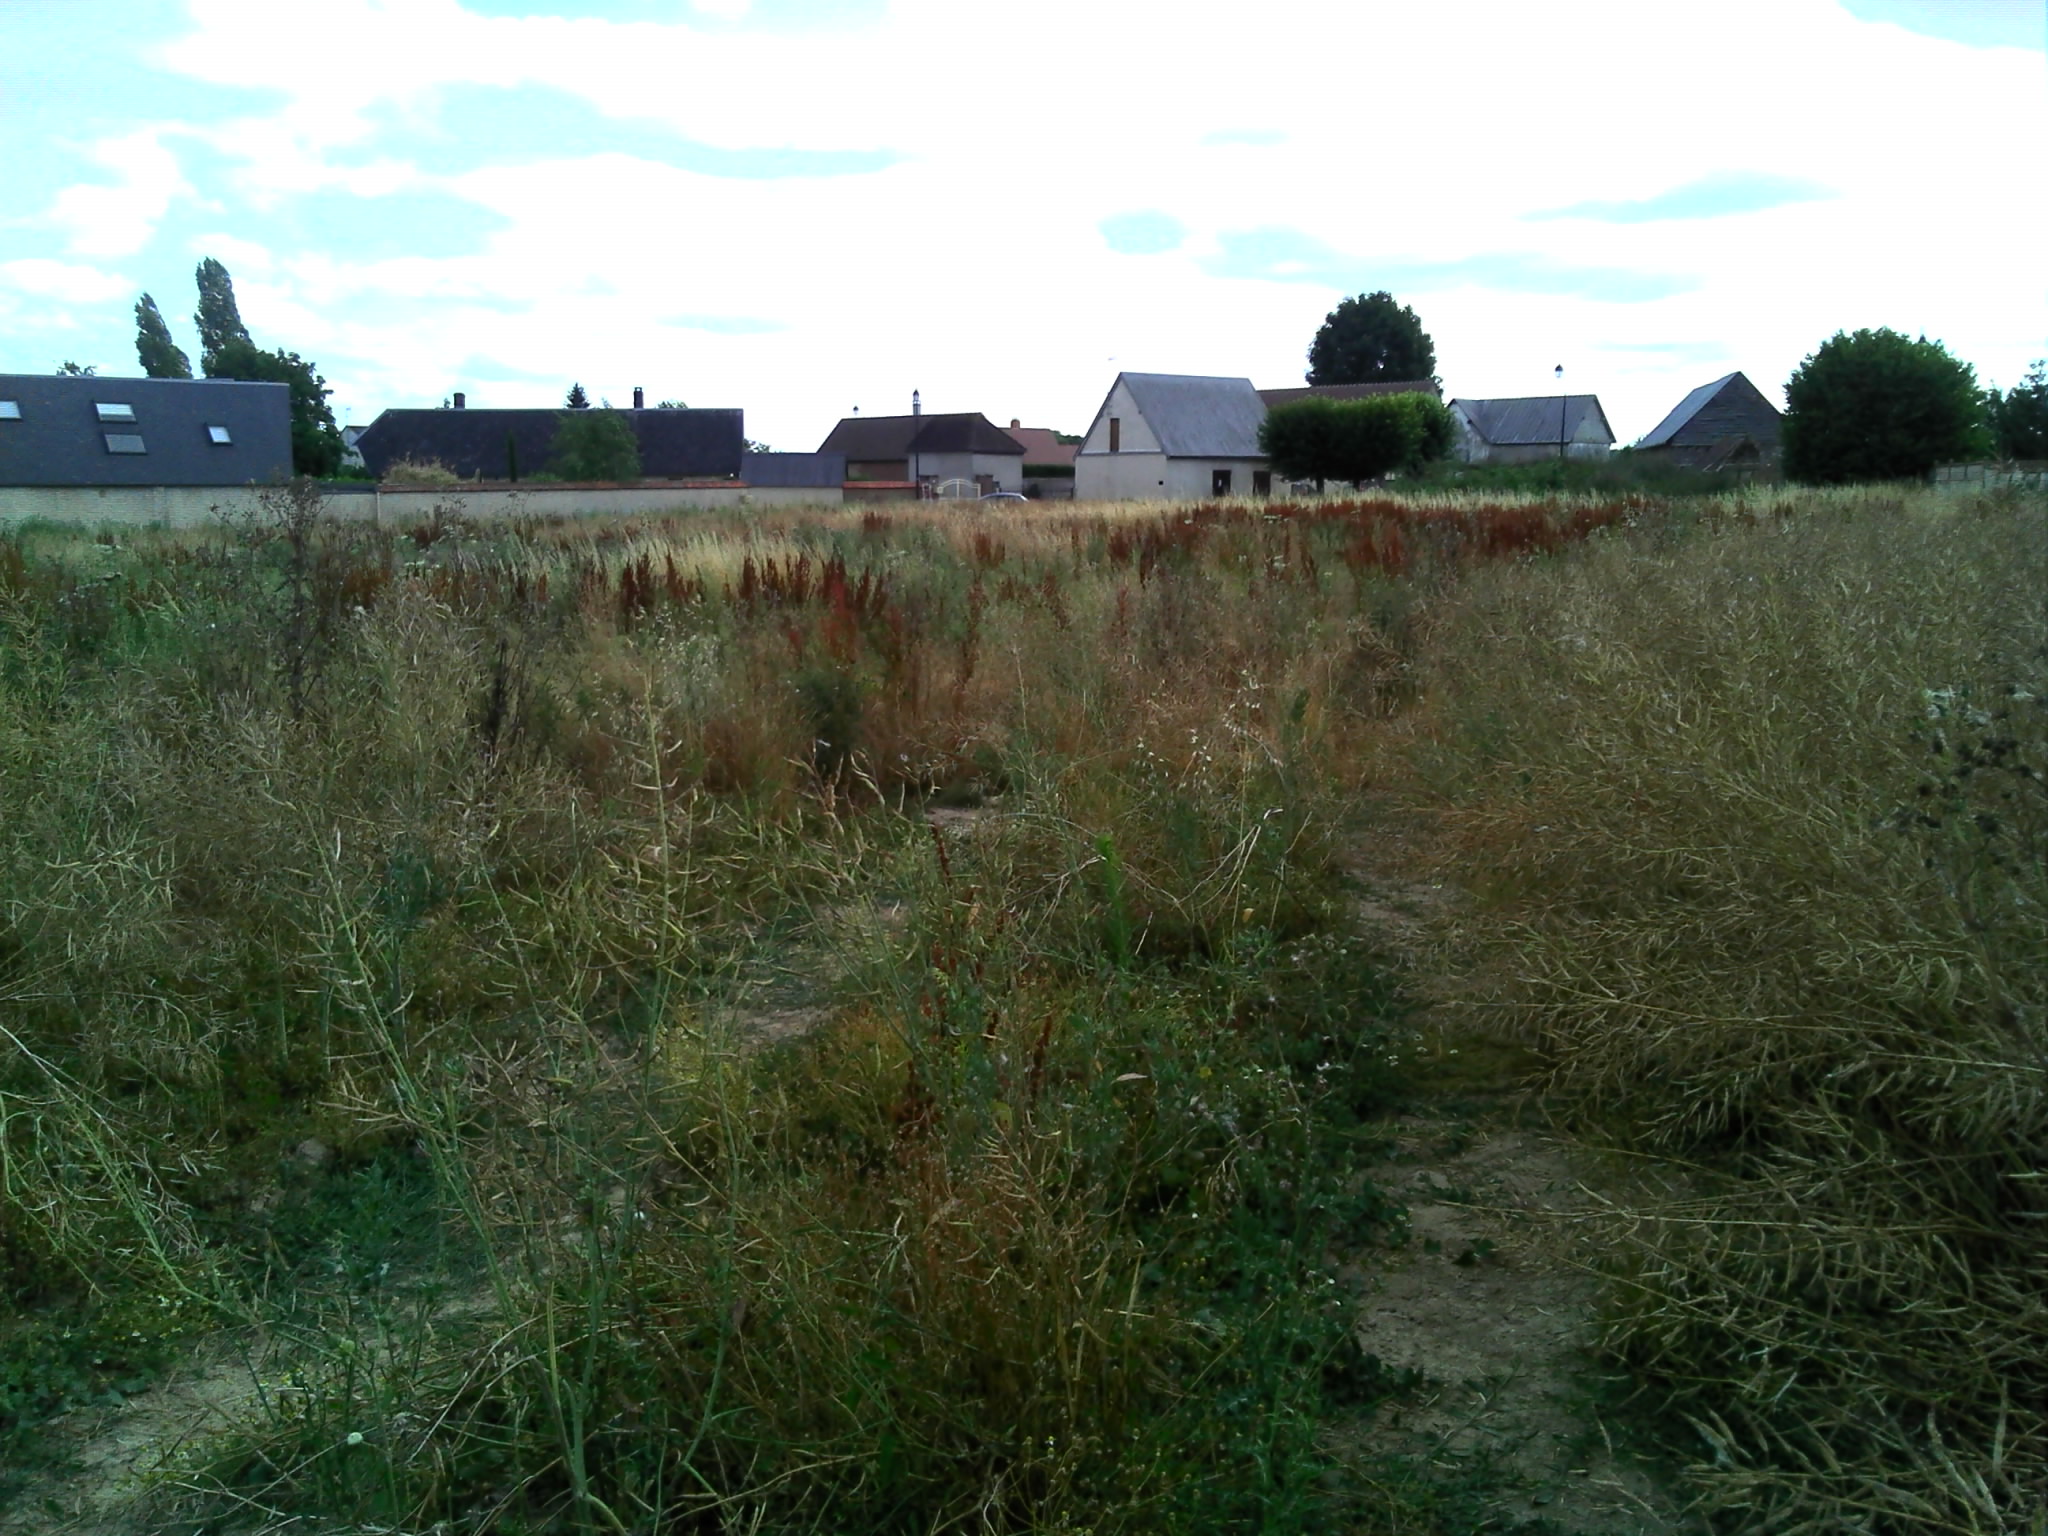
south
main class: Cropland
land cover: Rape and turnip rape
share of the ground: > 75 %
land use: Agriculture (excluding fallow land and kitchen gardens)
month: July
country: FR
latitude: 48.9482
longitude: 1.0900
